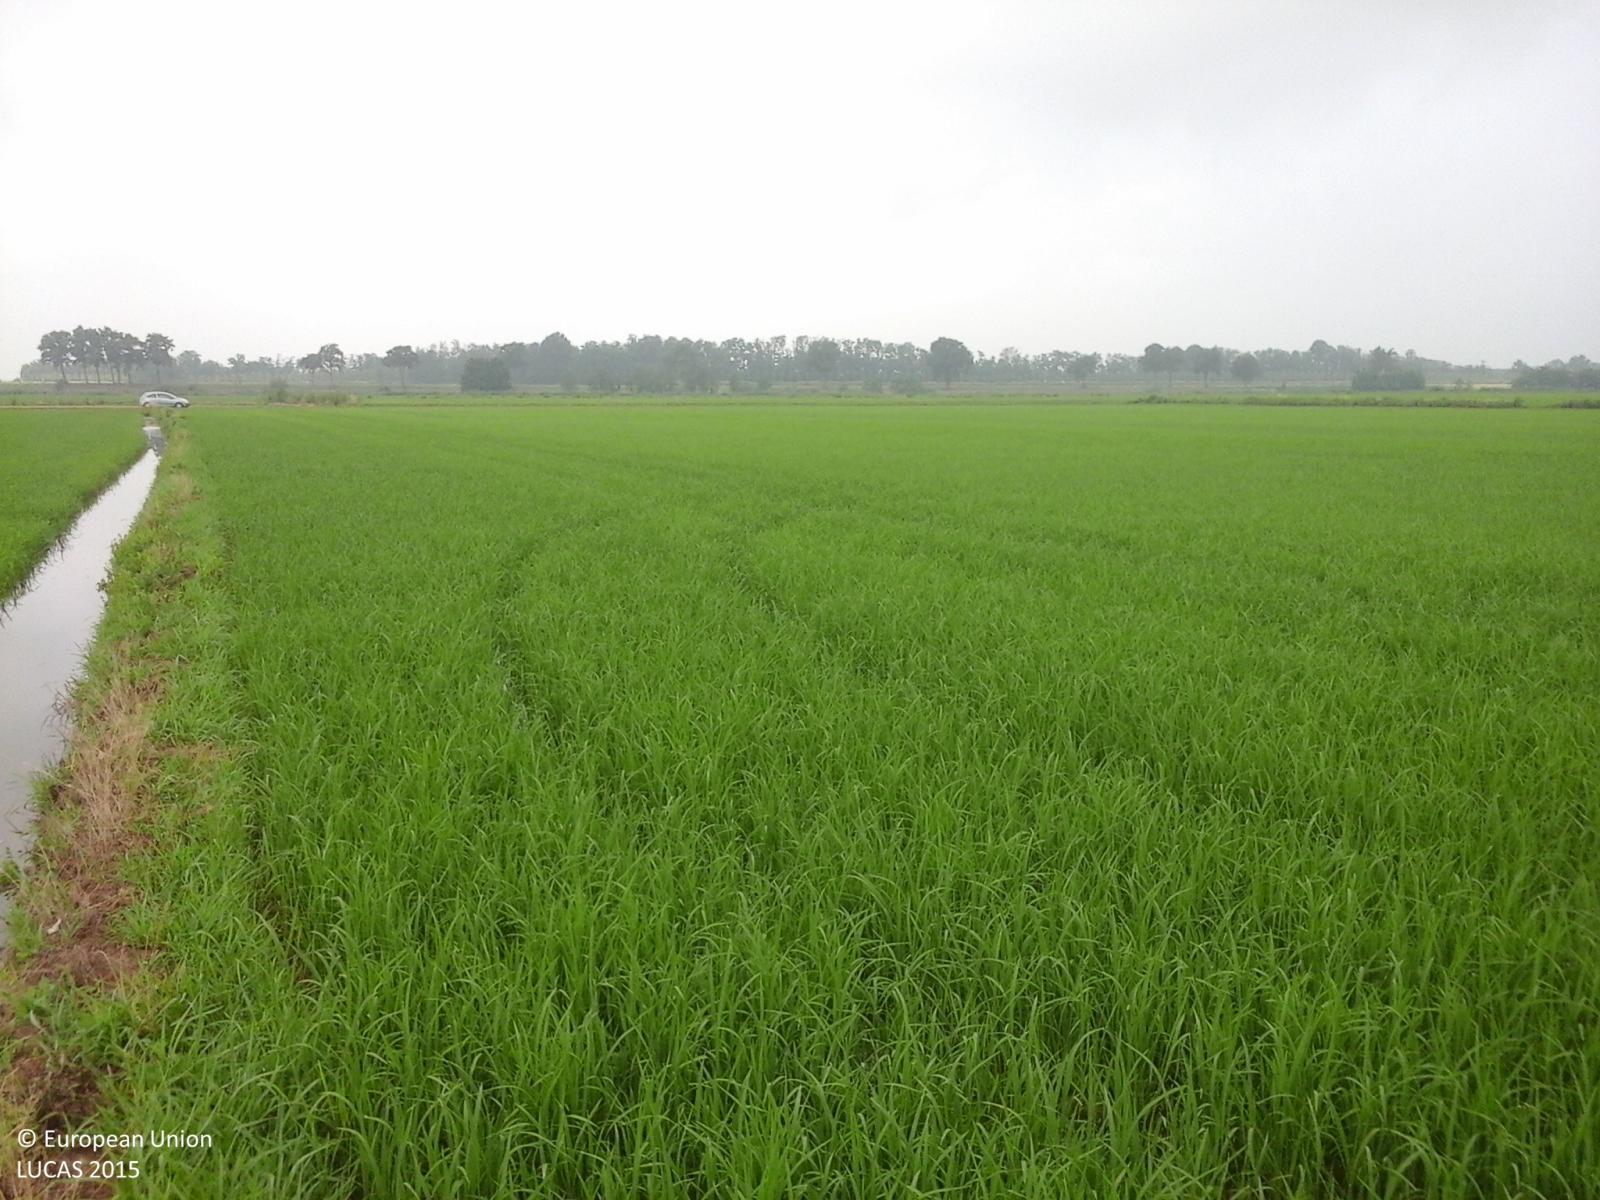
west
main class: Cropland
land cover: Rice
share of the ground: > 75 %
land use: Agriculture (excluding fallow land and kitchen gardens)
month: June
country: IT
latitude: 45.2072
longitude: 8.6402
